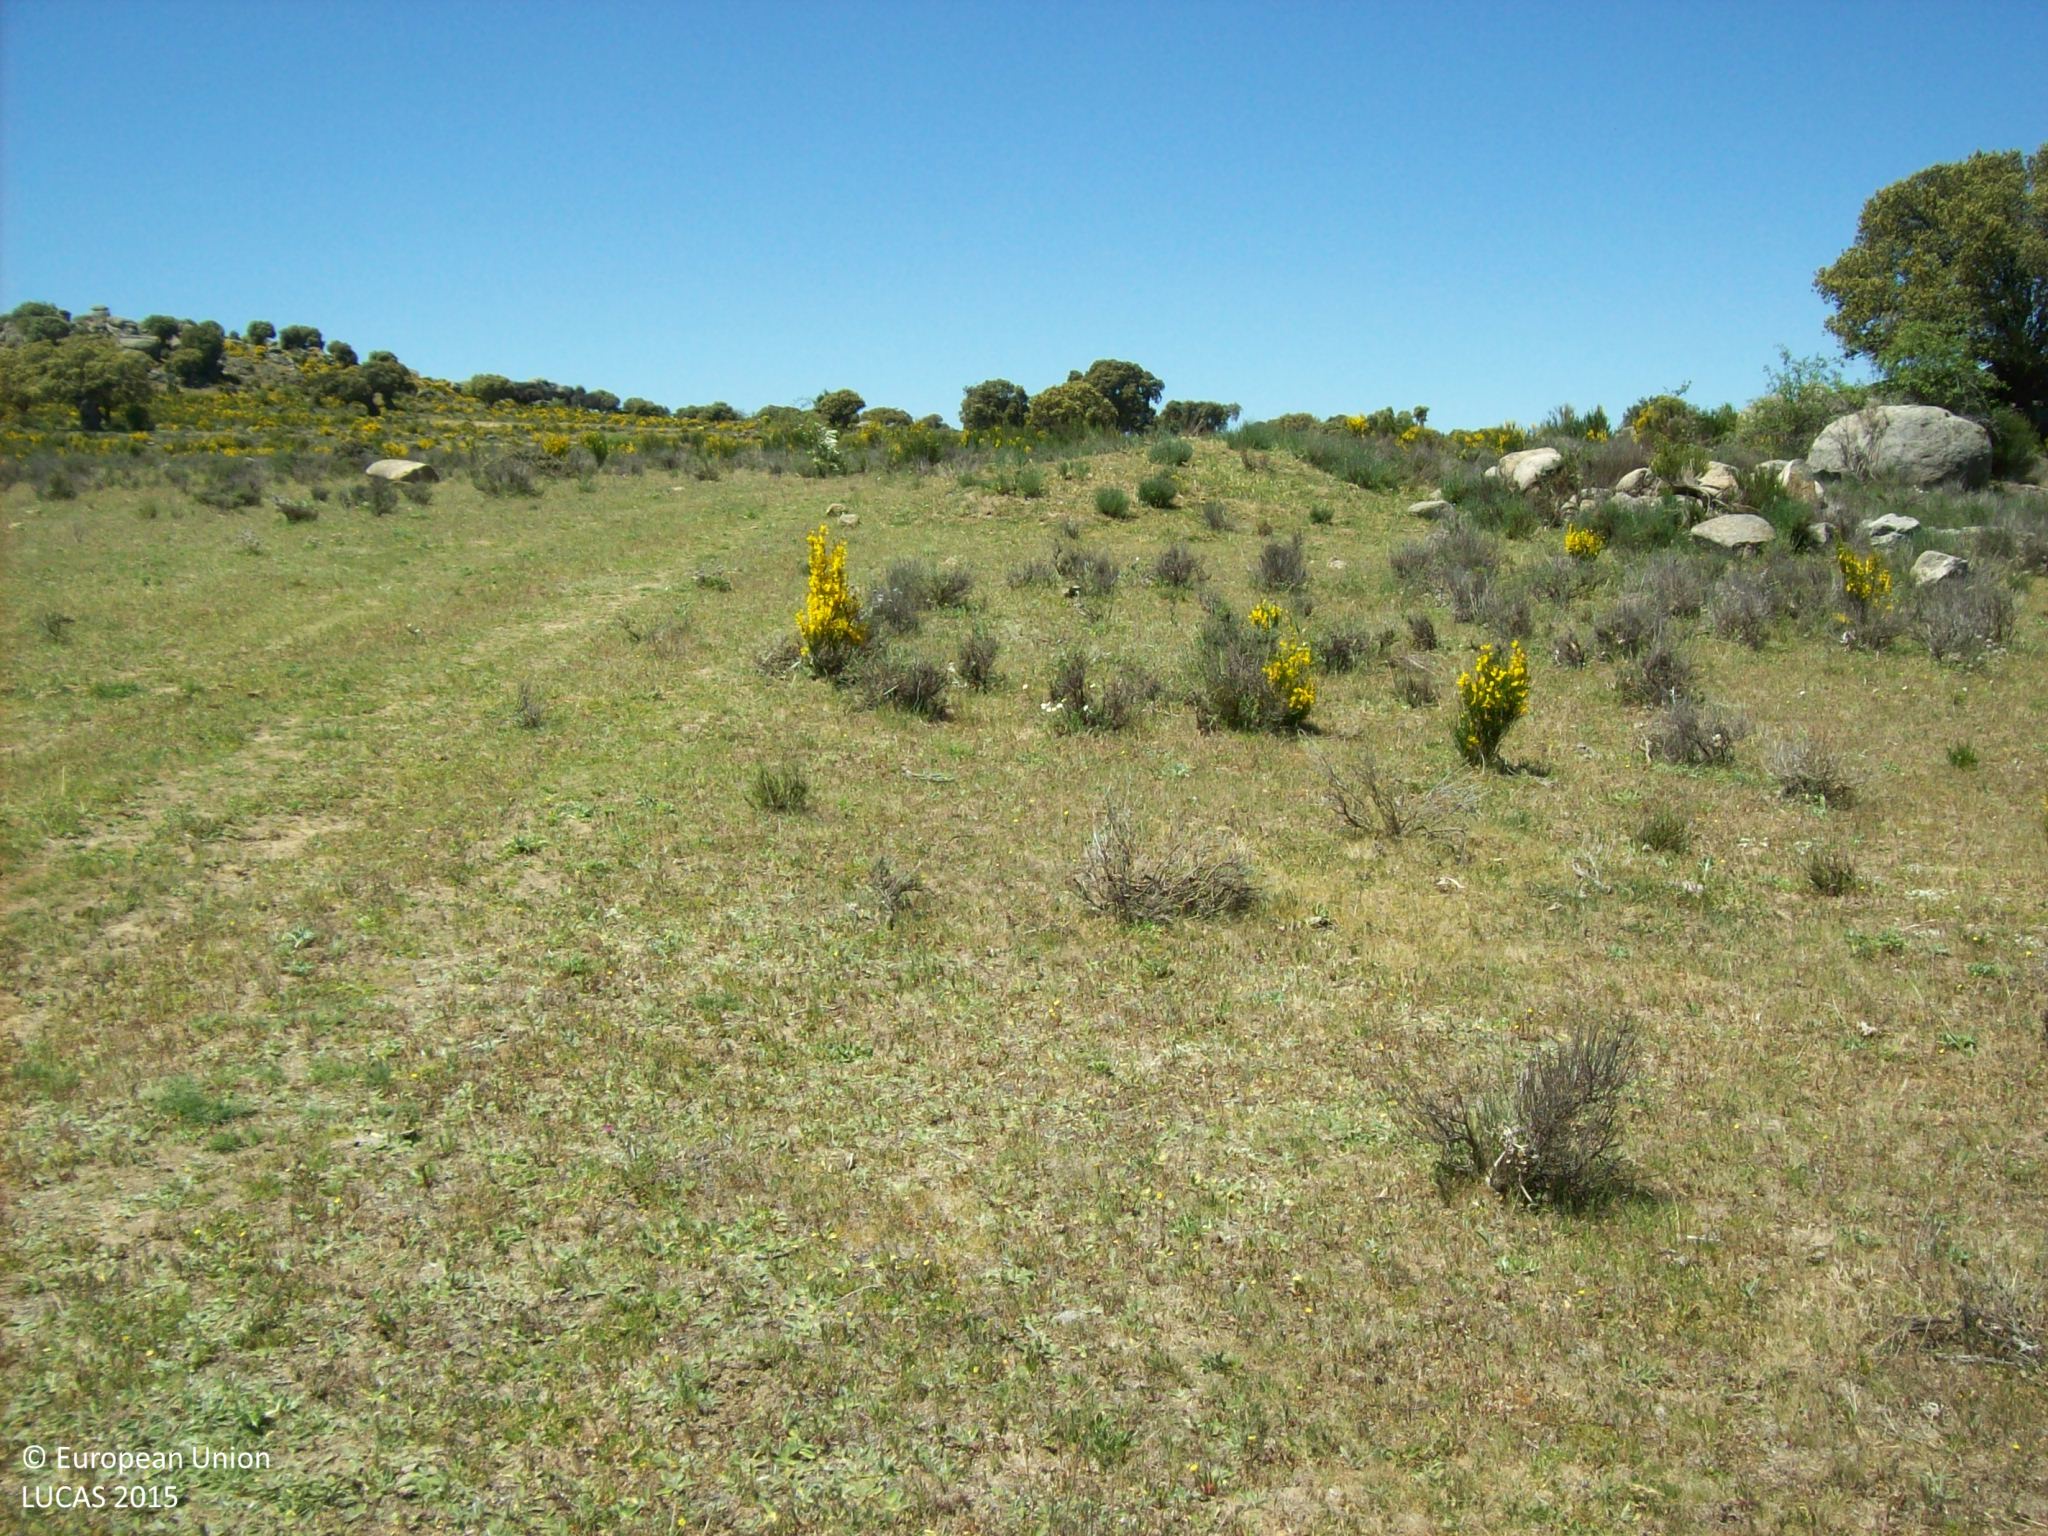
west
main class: Grassland
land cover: Grassland without tree/shrub cover
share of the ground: > 75 %
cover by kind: herbaceous plants 90 %, shrubs 5 %, consolidated bare surface 5 %
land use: Agriculture (excluding fallow land and kitchen gardens)
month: May
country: ES
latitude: 40.7134
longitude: -4.9399
